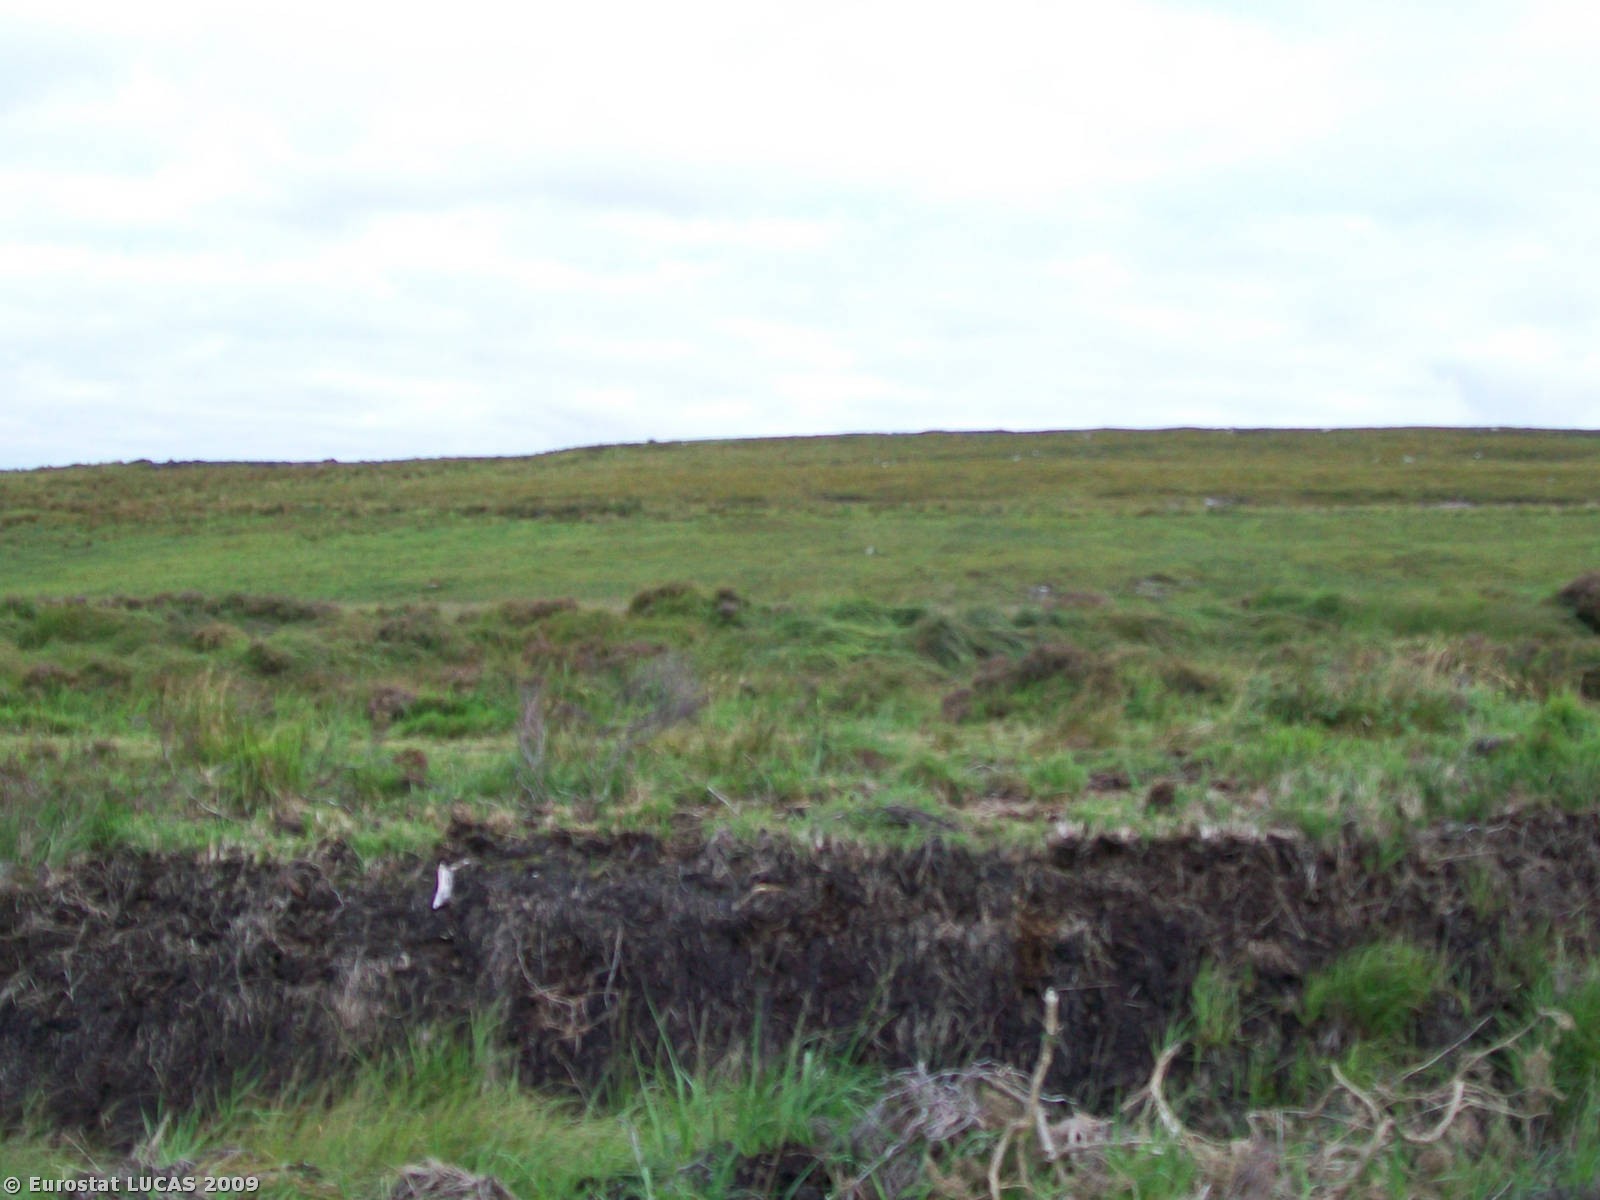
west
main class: Wetlands
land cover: Peatbogs
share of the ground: > 75 %
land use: Mining and quarrying
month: August
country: IE
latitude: 52.7554
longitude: -9.1705
